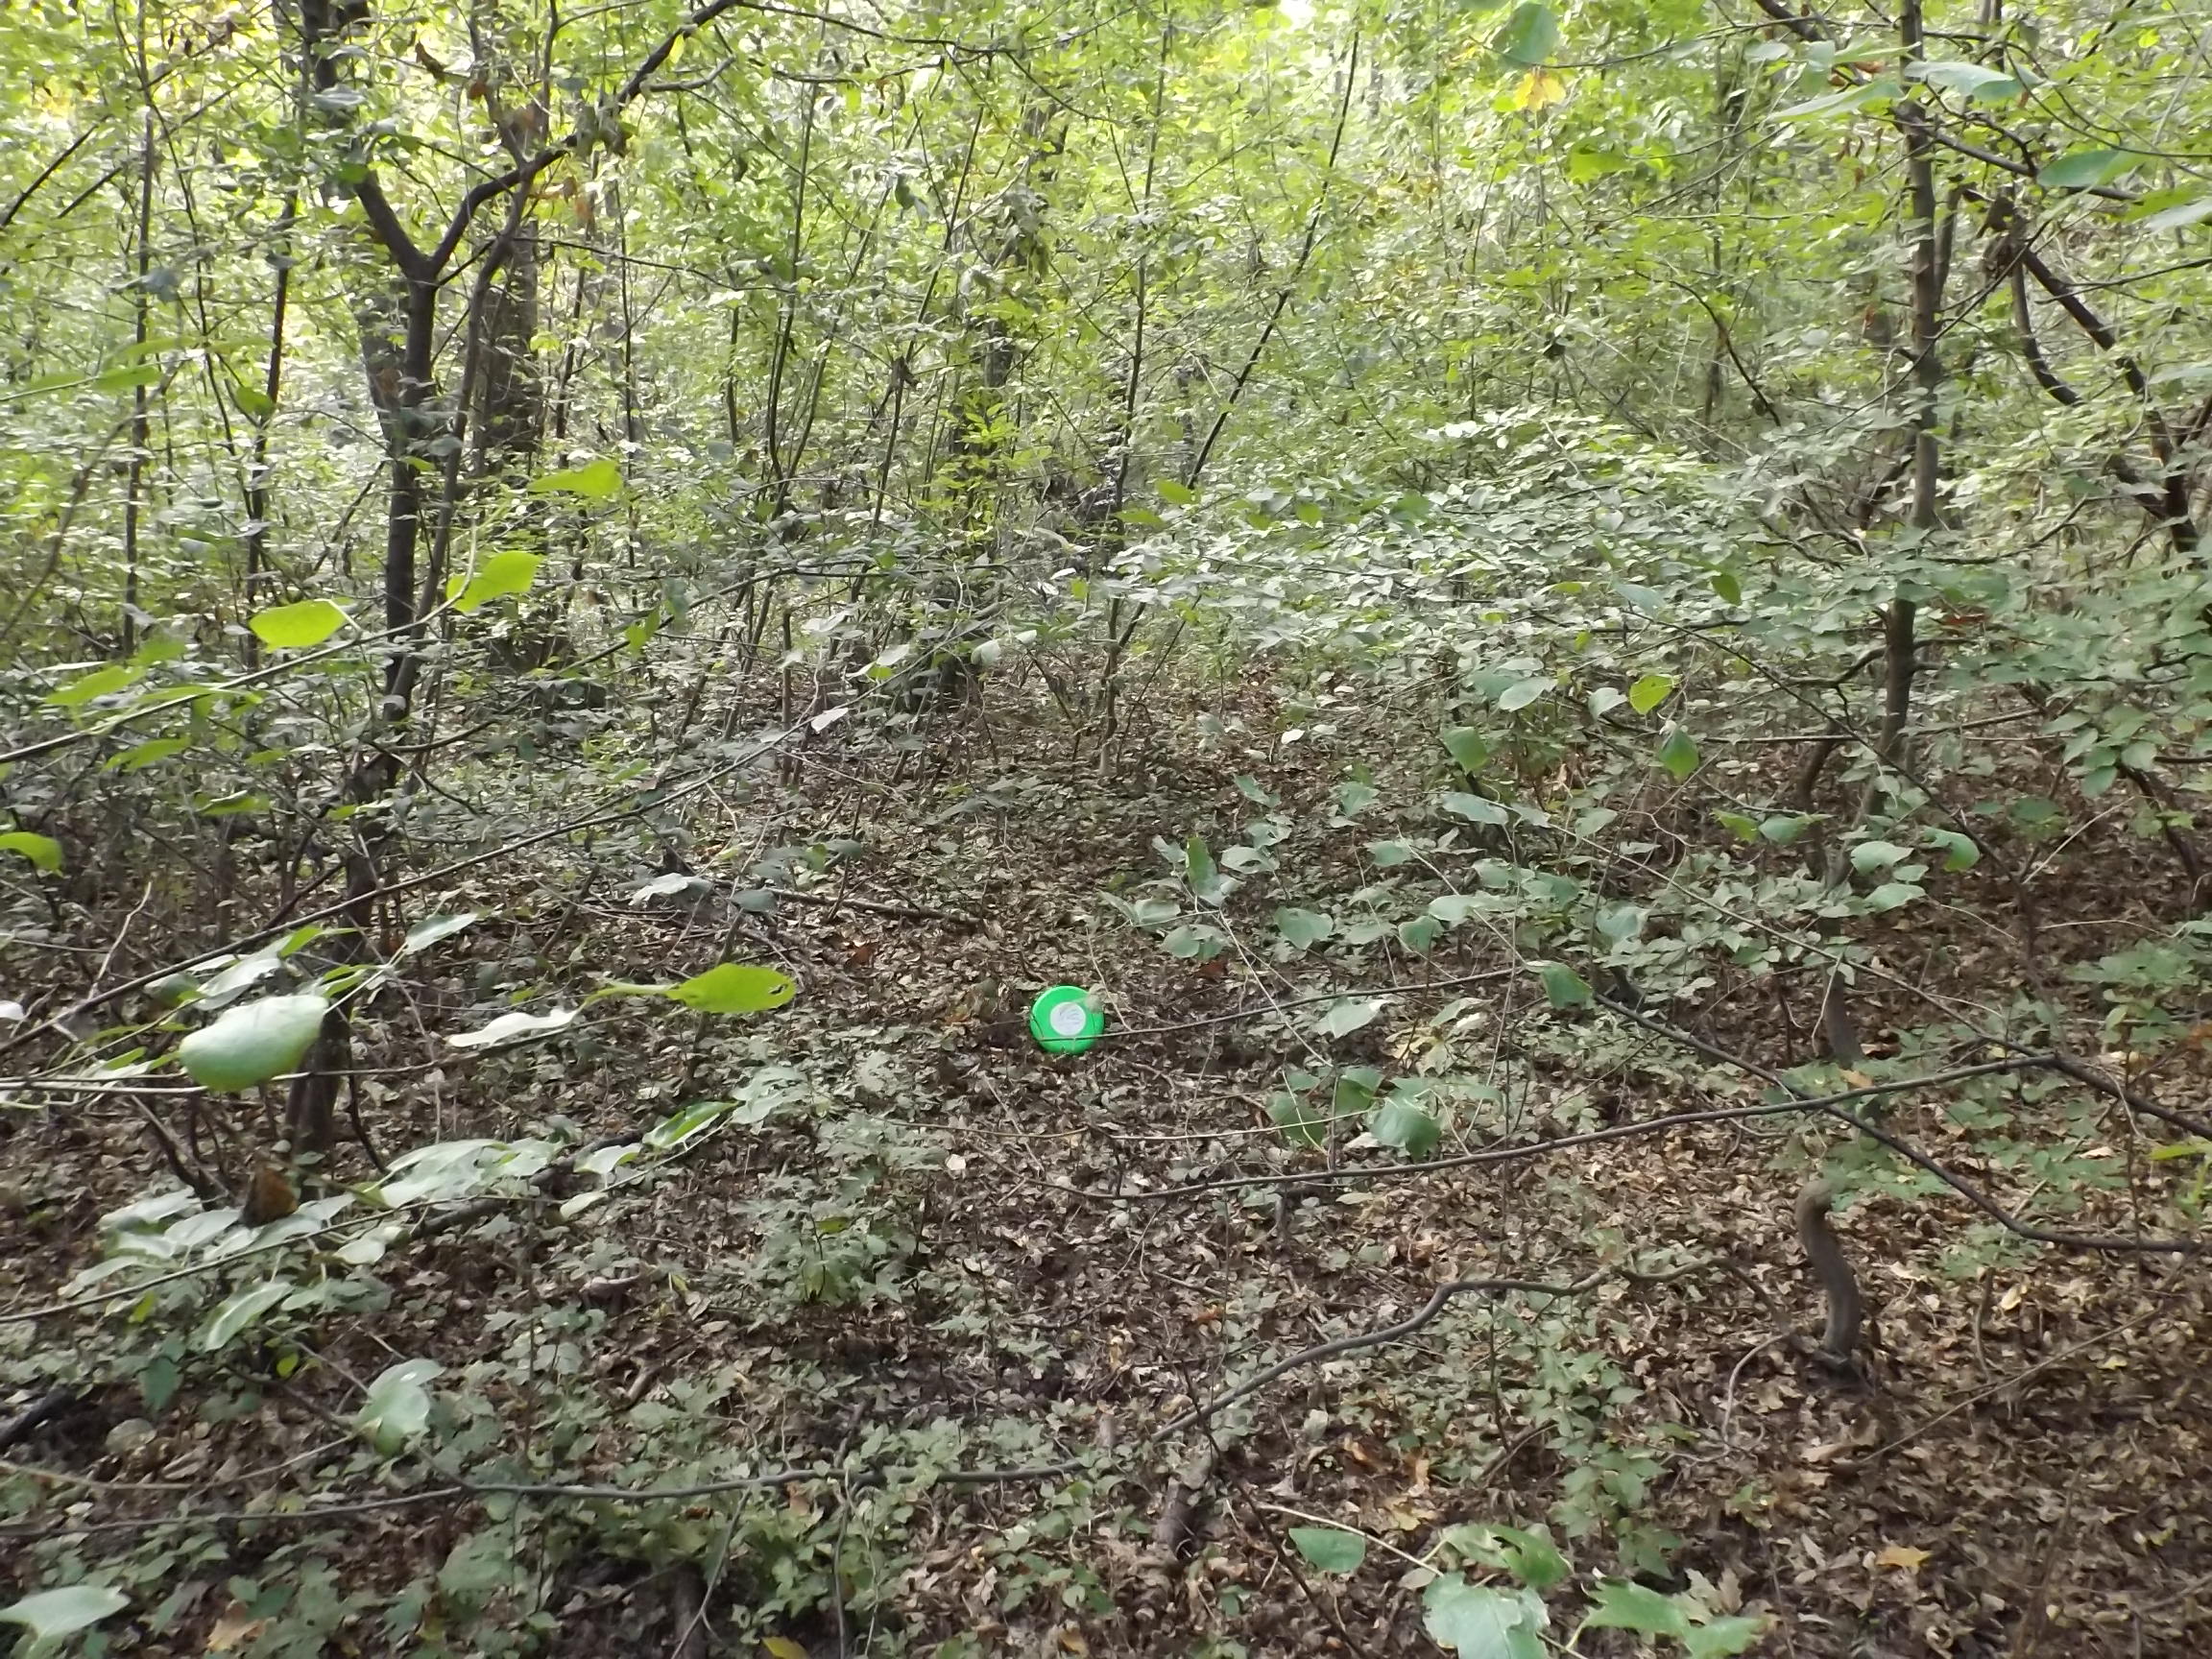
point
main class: Woodland
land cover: Broadleaved woodland
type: beech forest
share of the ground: > 75 %
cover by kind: broadleaved forest trees 100 %
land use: Forestry
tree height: > 5 m
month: October
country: BG
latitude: 43.8655
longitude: 26.8279
